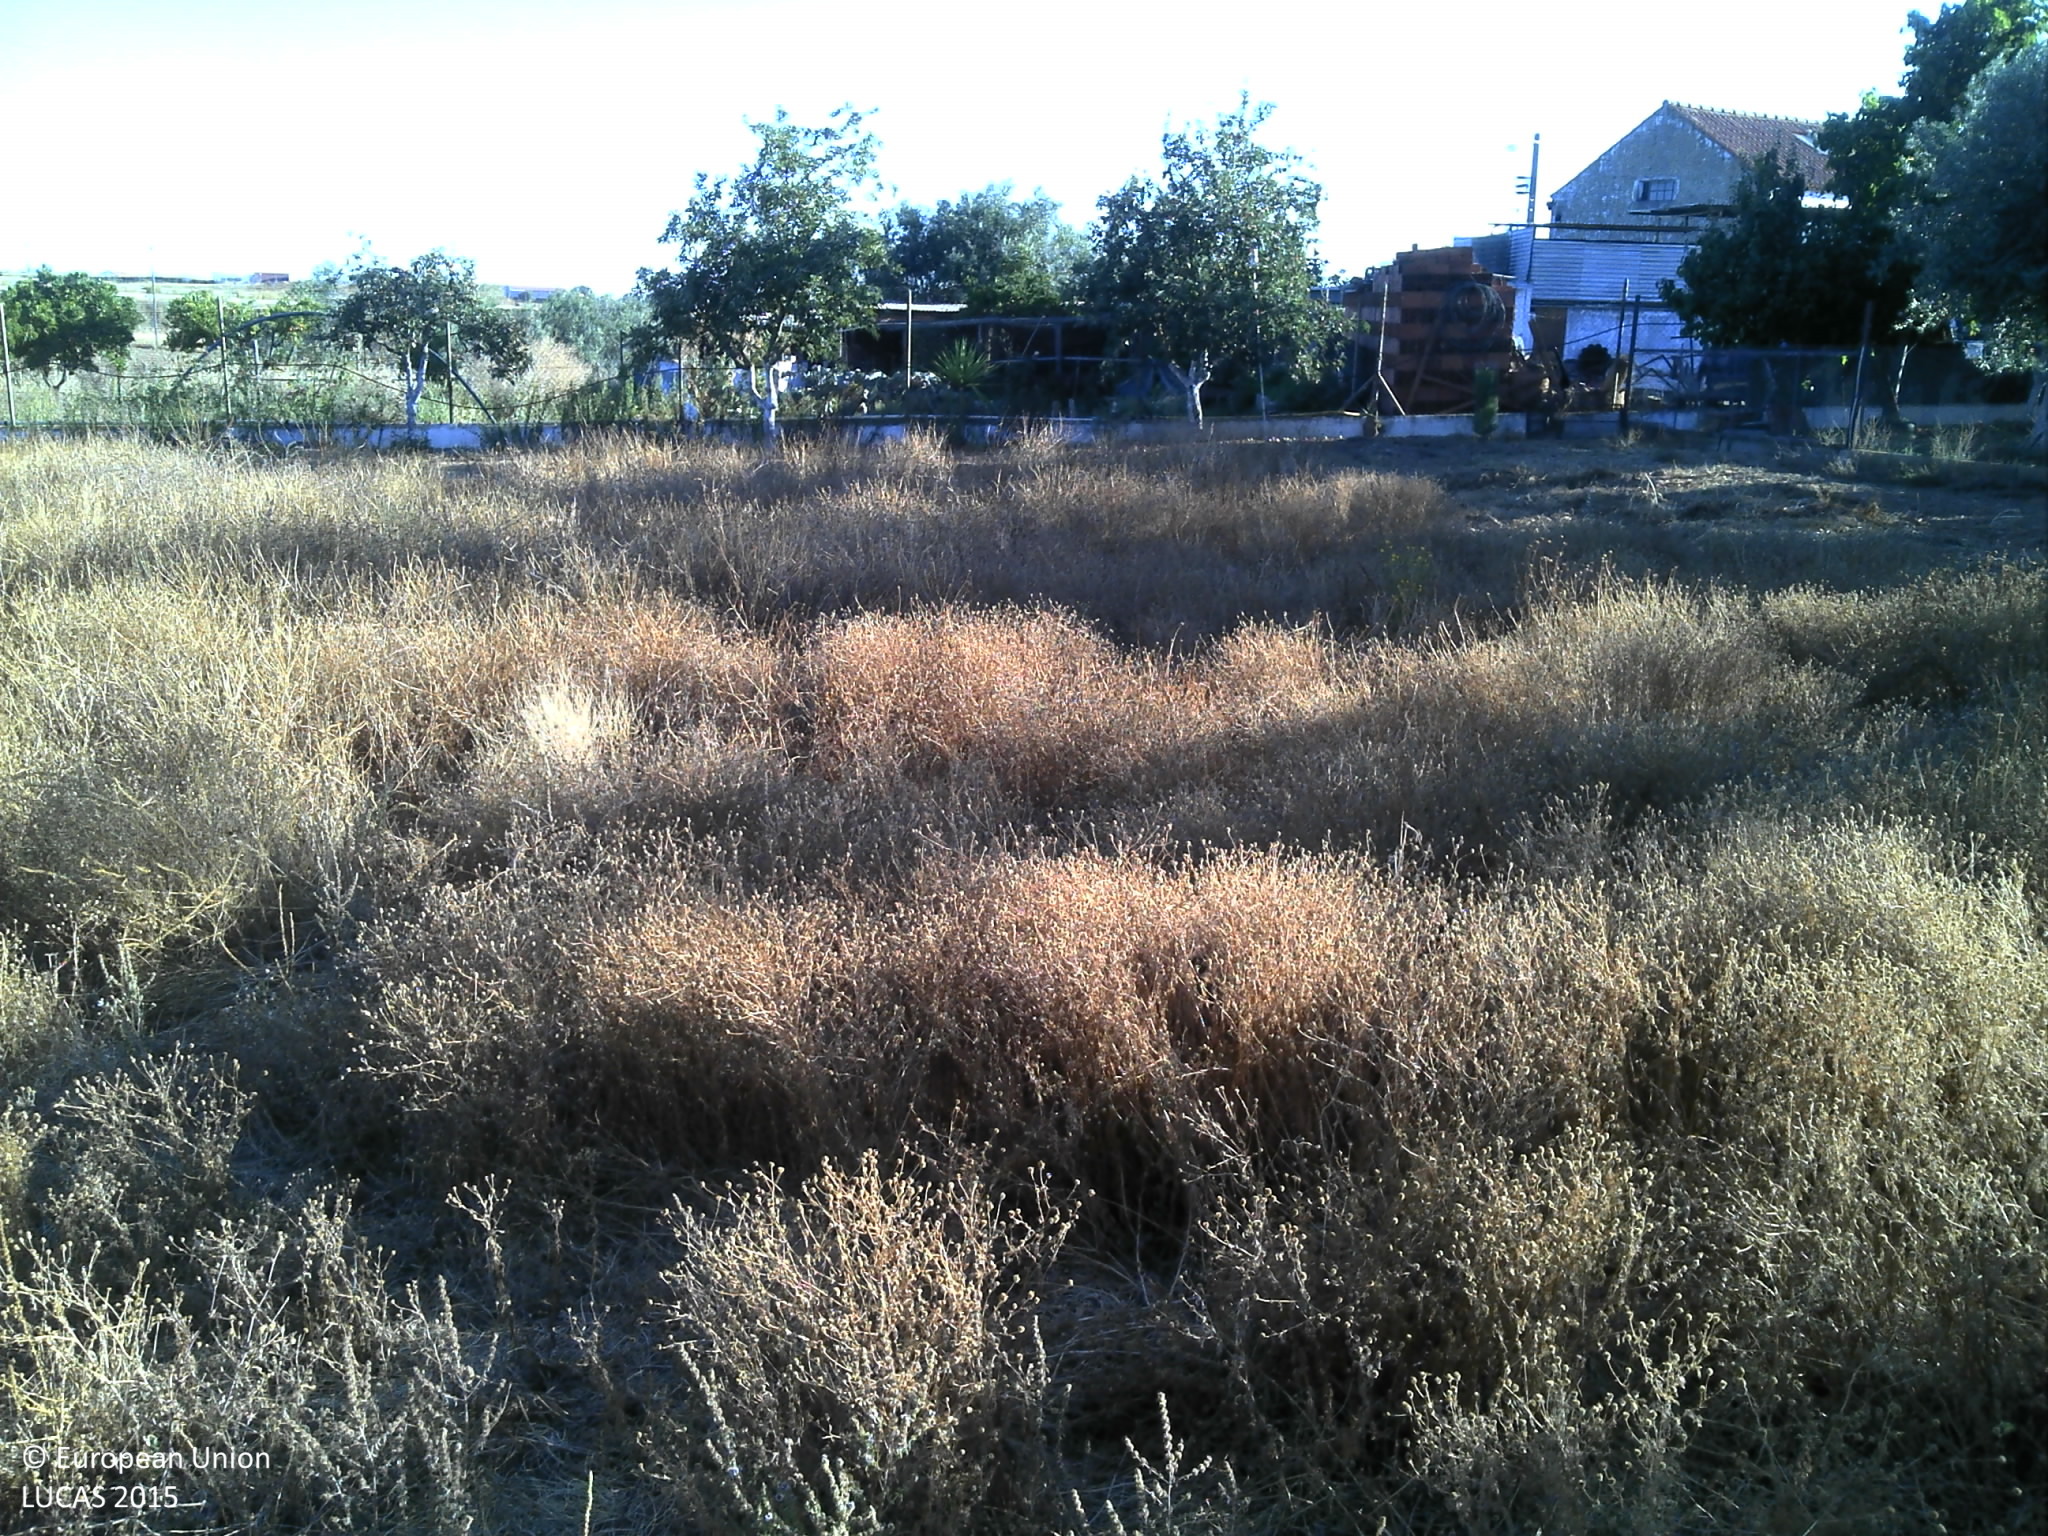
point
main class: Shrubland
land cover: Shrubland without tree cover
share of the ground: 50 - 75 %
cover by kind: unconsolidated bare surface 50 %, shrubs 25 %, herbaceous plants 25 %
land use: Fallow land
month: July
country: PT
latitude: 38.8929
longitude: -7.5501
